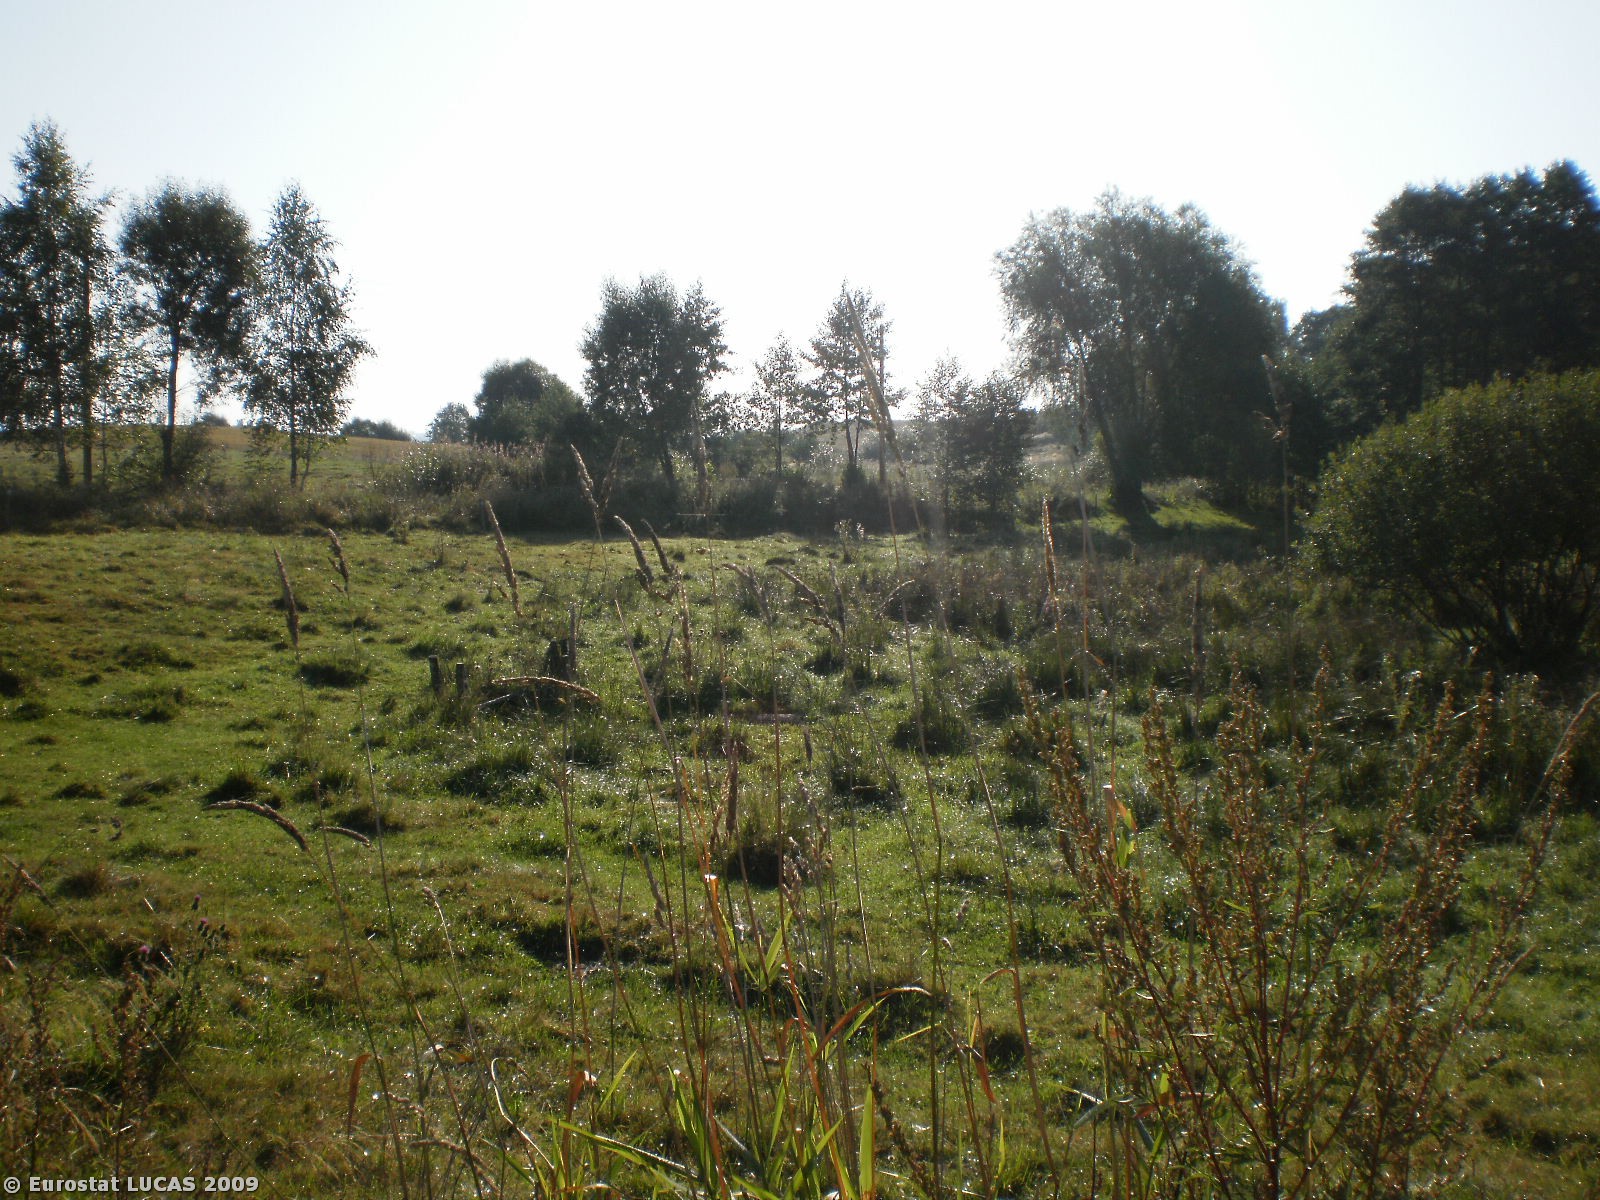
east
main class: Cropland
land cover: Oats
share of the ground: < 10 %
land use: Agriculture (excluding fallow land and kitchen gardens)
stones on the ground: < 10 %
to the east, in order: Oats; Grassland without tree/shrub cover; Tracks; Grass margins; Single bushes/trees; Grass margins; Electric lines; Grassland without tree/shrub cover; Electric lines; Grassland without tree/shrub cover; Oats
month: September
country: PL
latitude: 53.8877
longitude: 22.0622
